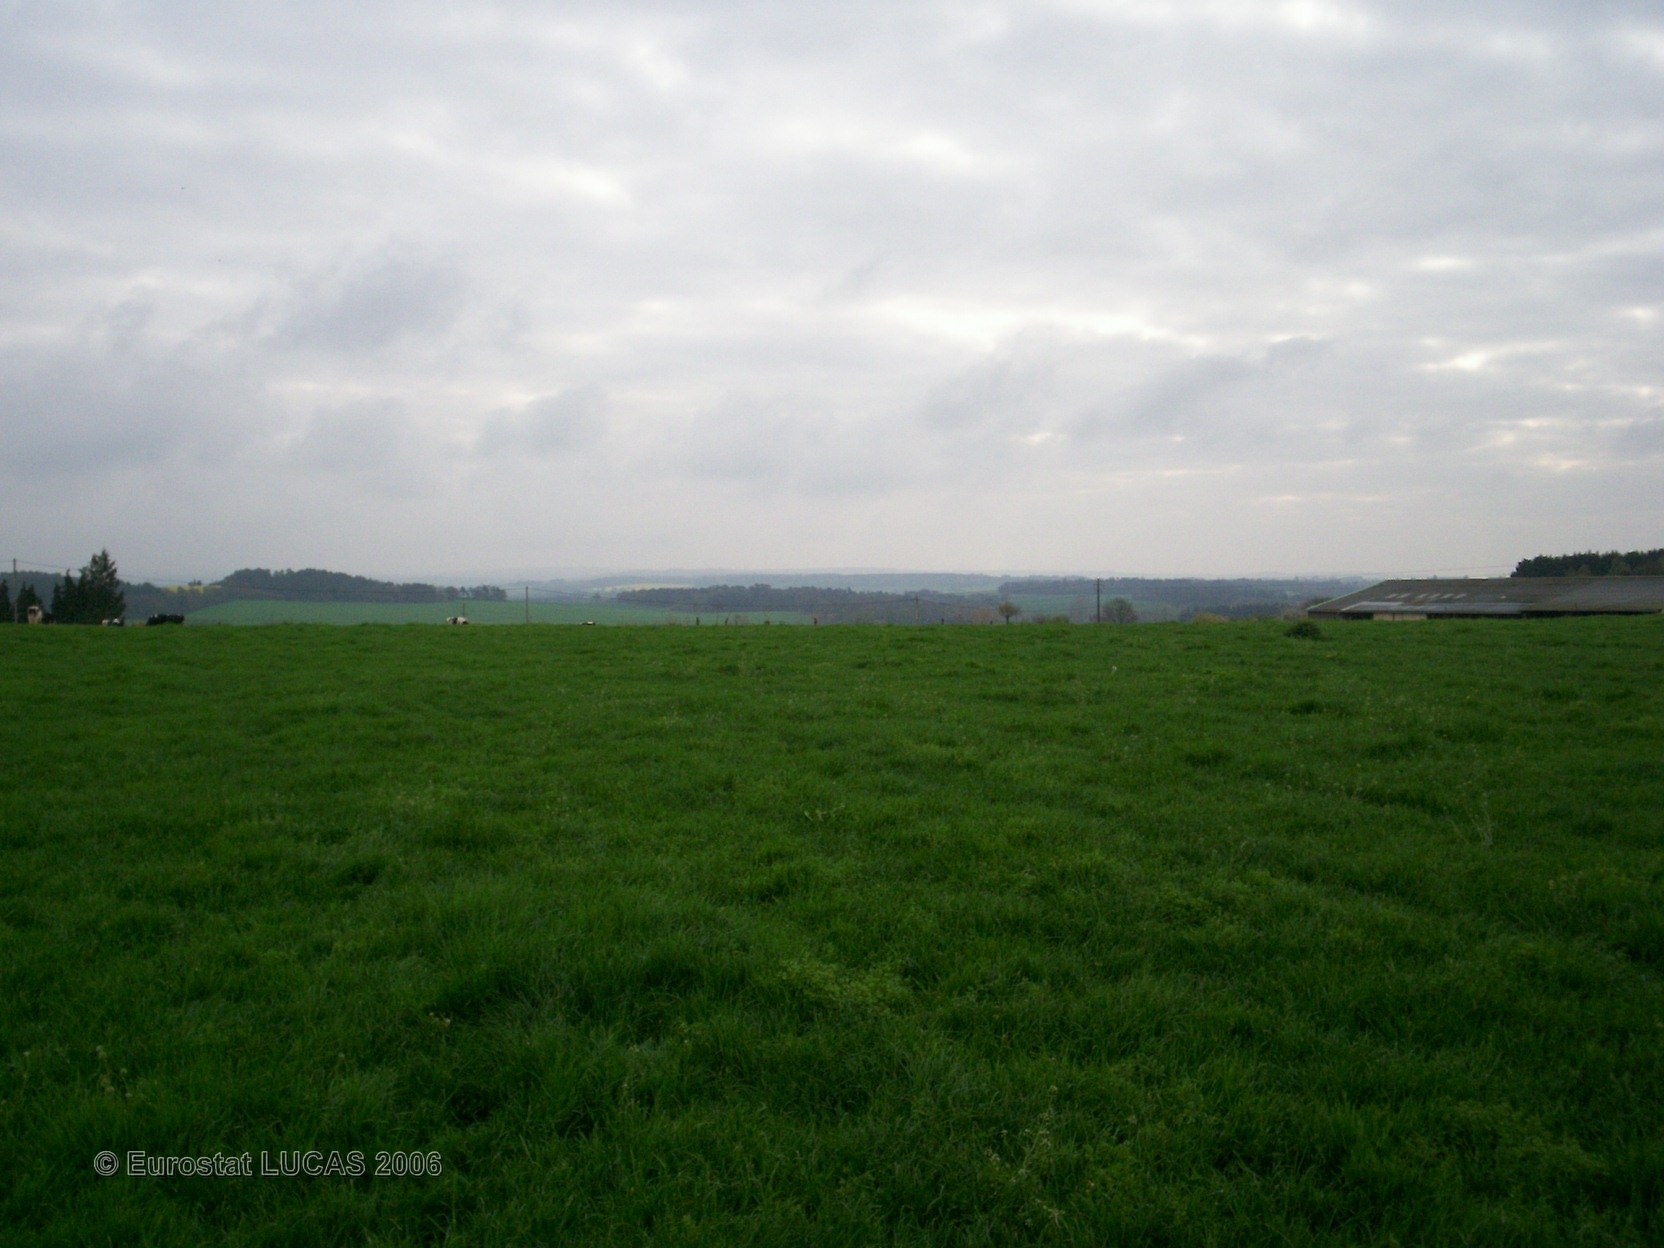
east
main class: Grassland
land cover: Grassland without tree/shrub cover
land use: Agriculture (excluding fallow land and kitchen gardens)
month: April
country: FR
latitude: 47.9788
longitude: -2.3694
